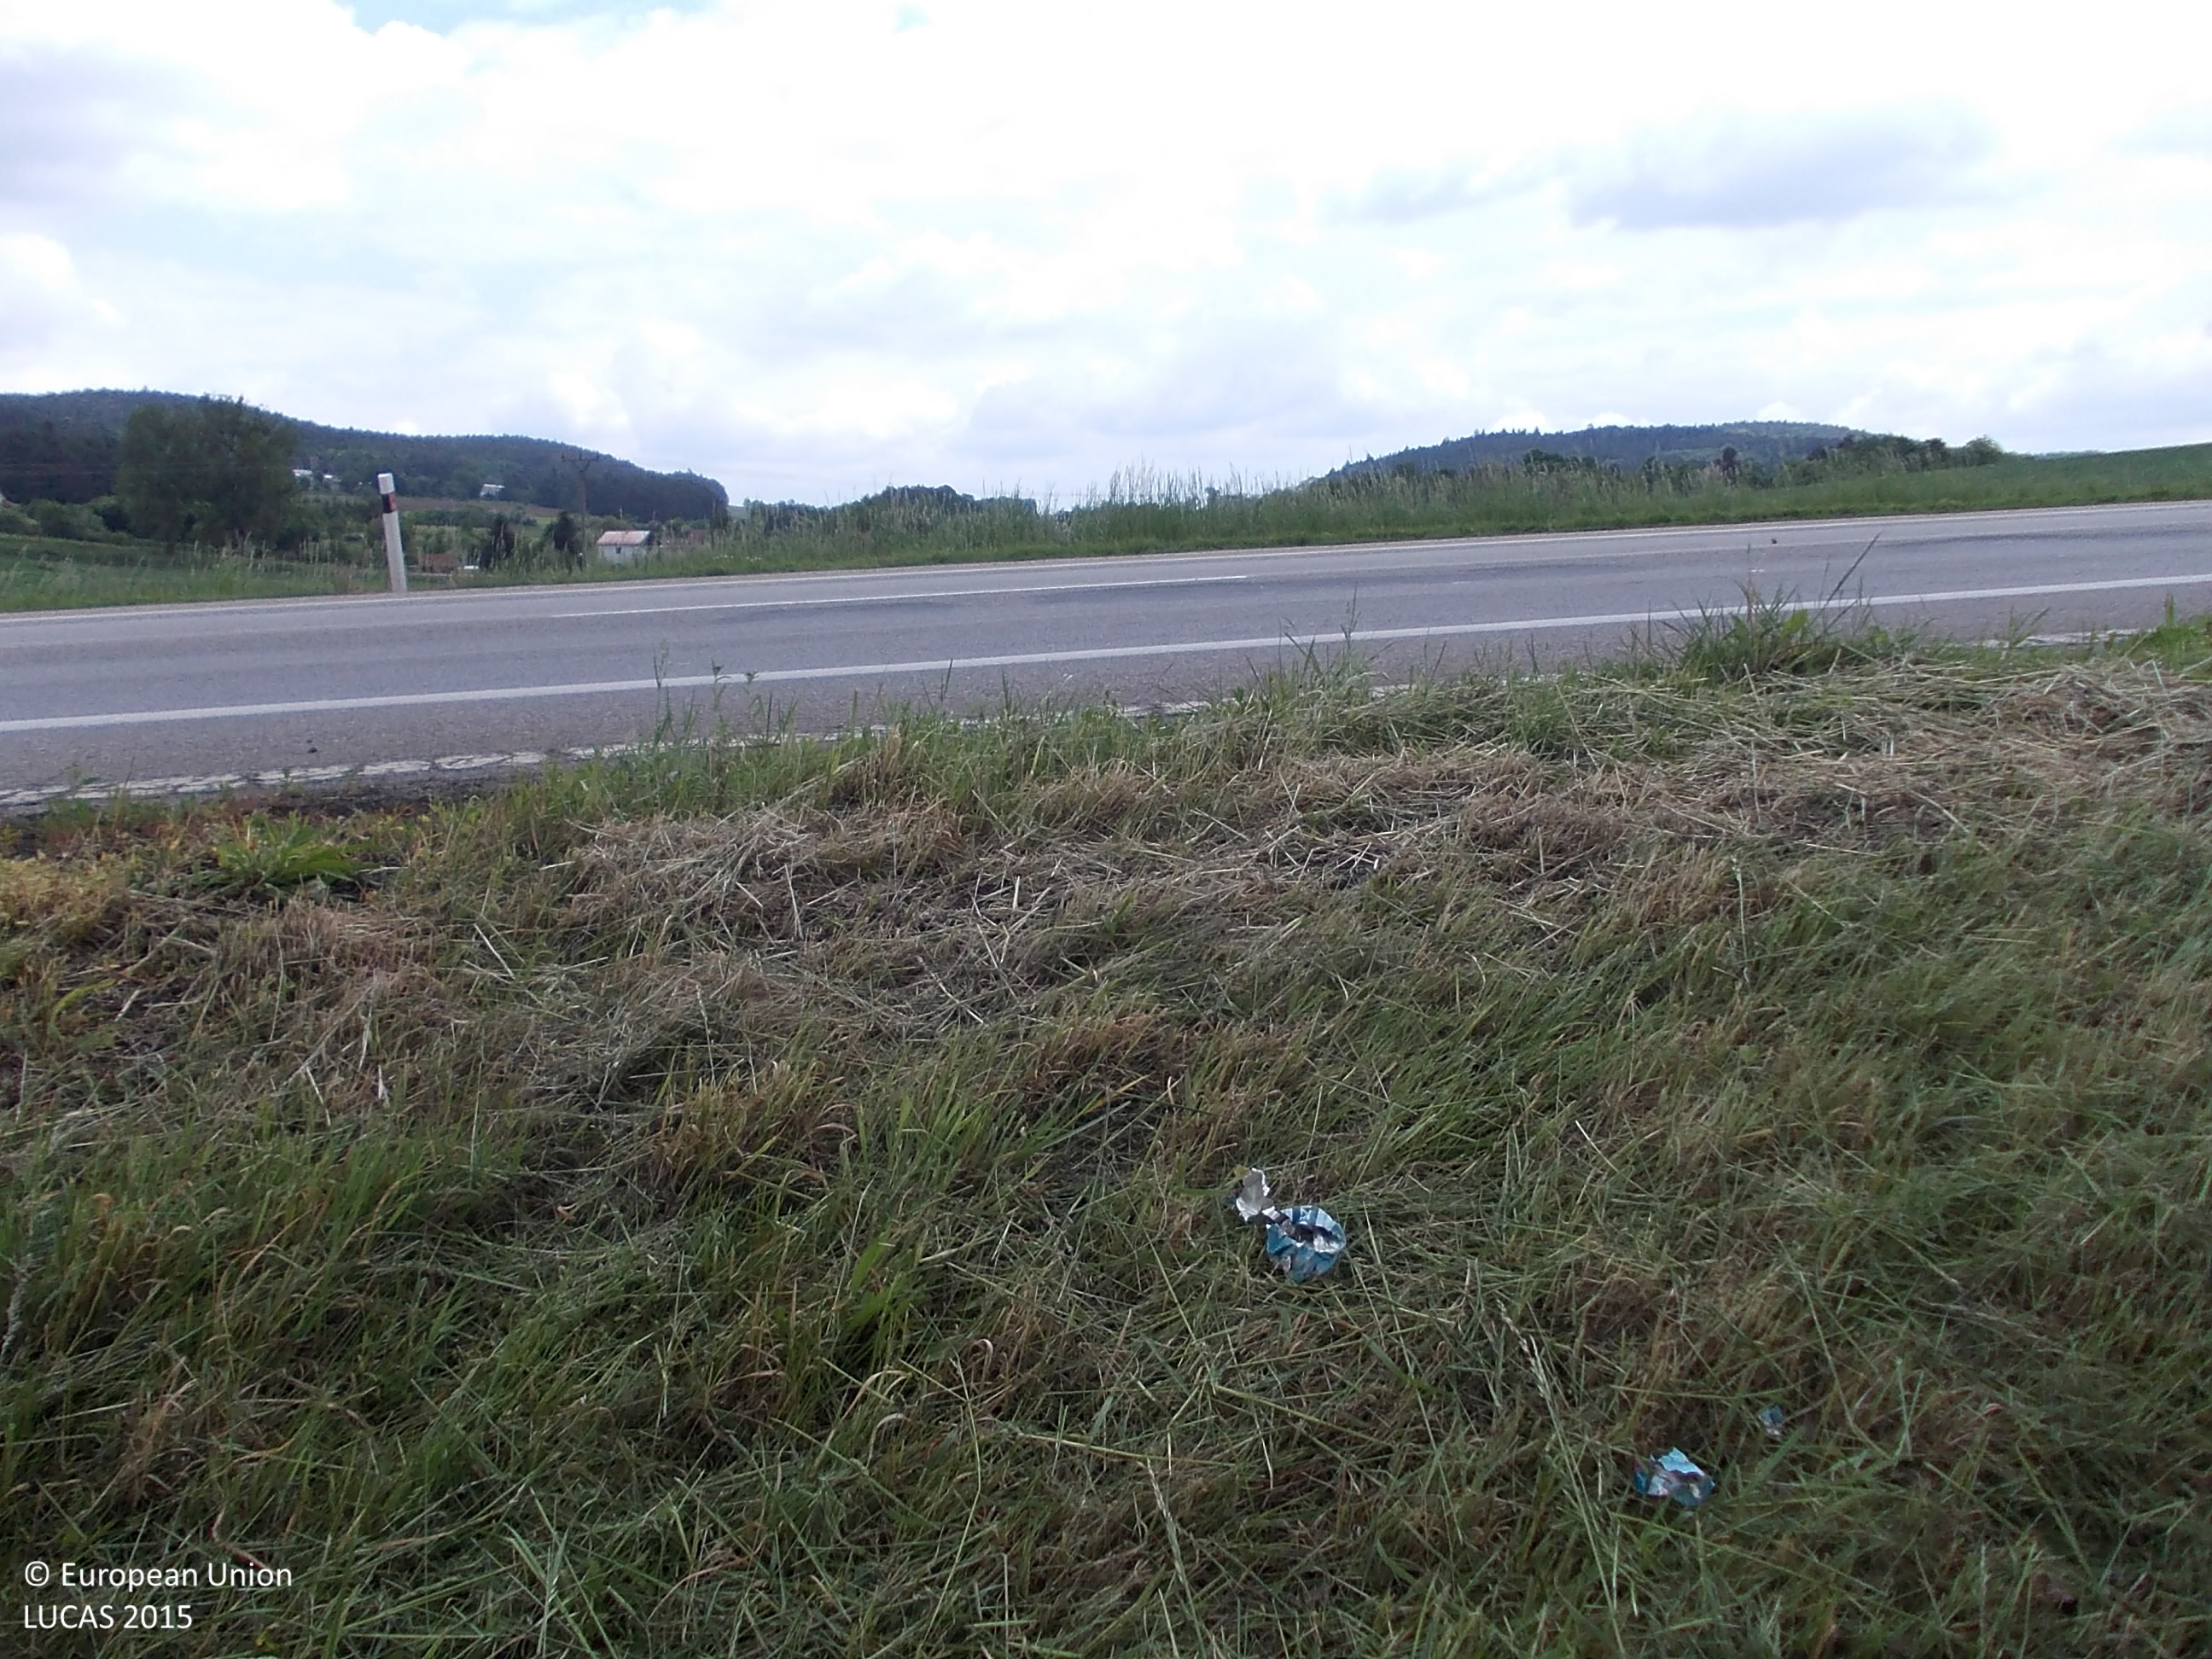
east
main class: Grassland
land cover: Grassland with sparse tree/shrub cover
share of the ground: > 75 %
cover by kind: herbaceous plants 95 %, broadleaved forest trees 5 %
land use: Road transport
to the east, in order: Grassland with sparse tree/shrub cover; Paved roads, cycling and walking lanes; Grassland without tree/shrub cover; Common wheat; Electric lines; Common wheat; Rye; Common wheat; Electric lines; Common wheat
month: May
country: CZ
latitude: 49.2348
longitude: 13.9146
